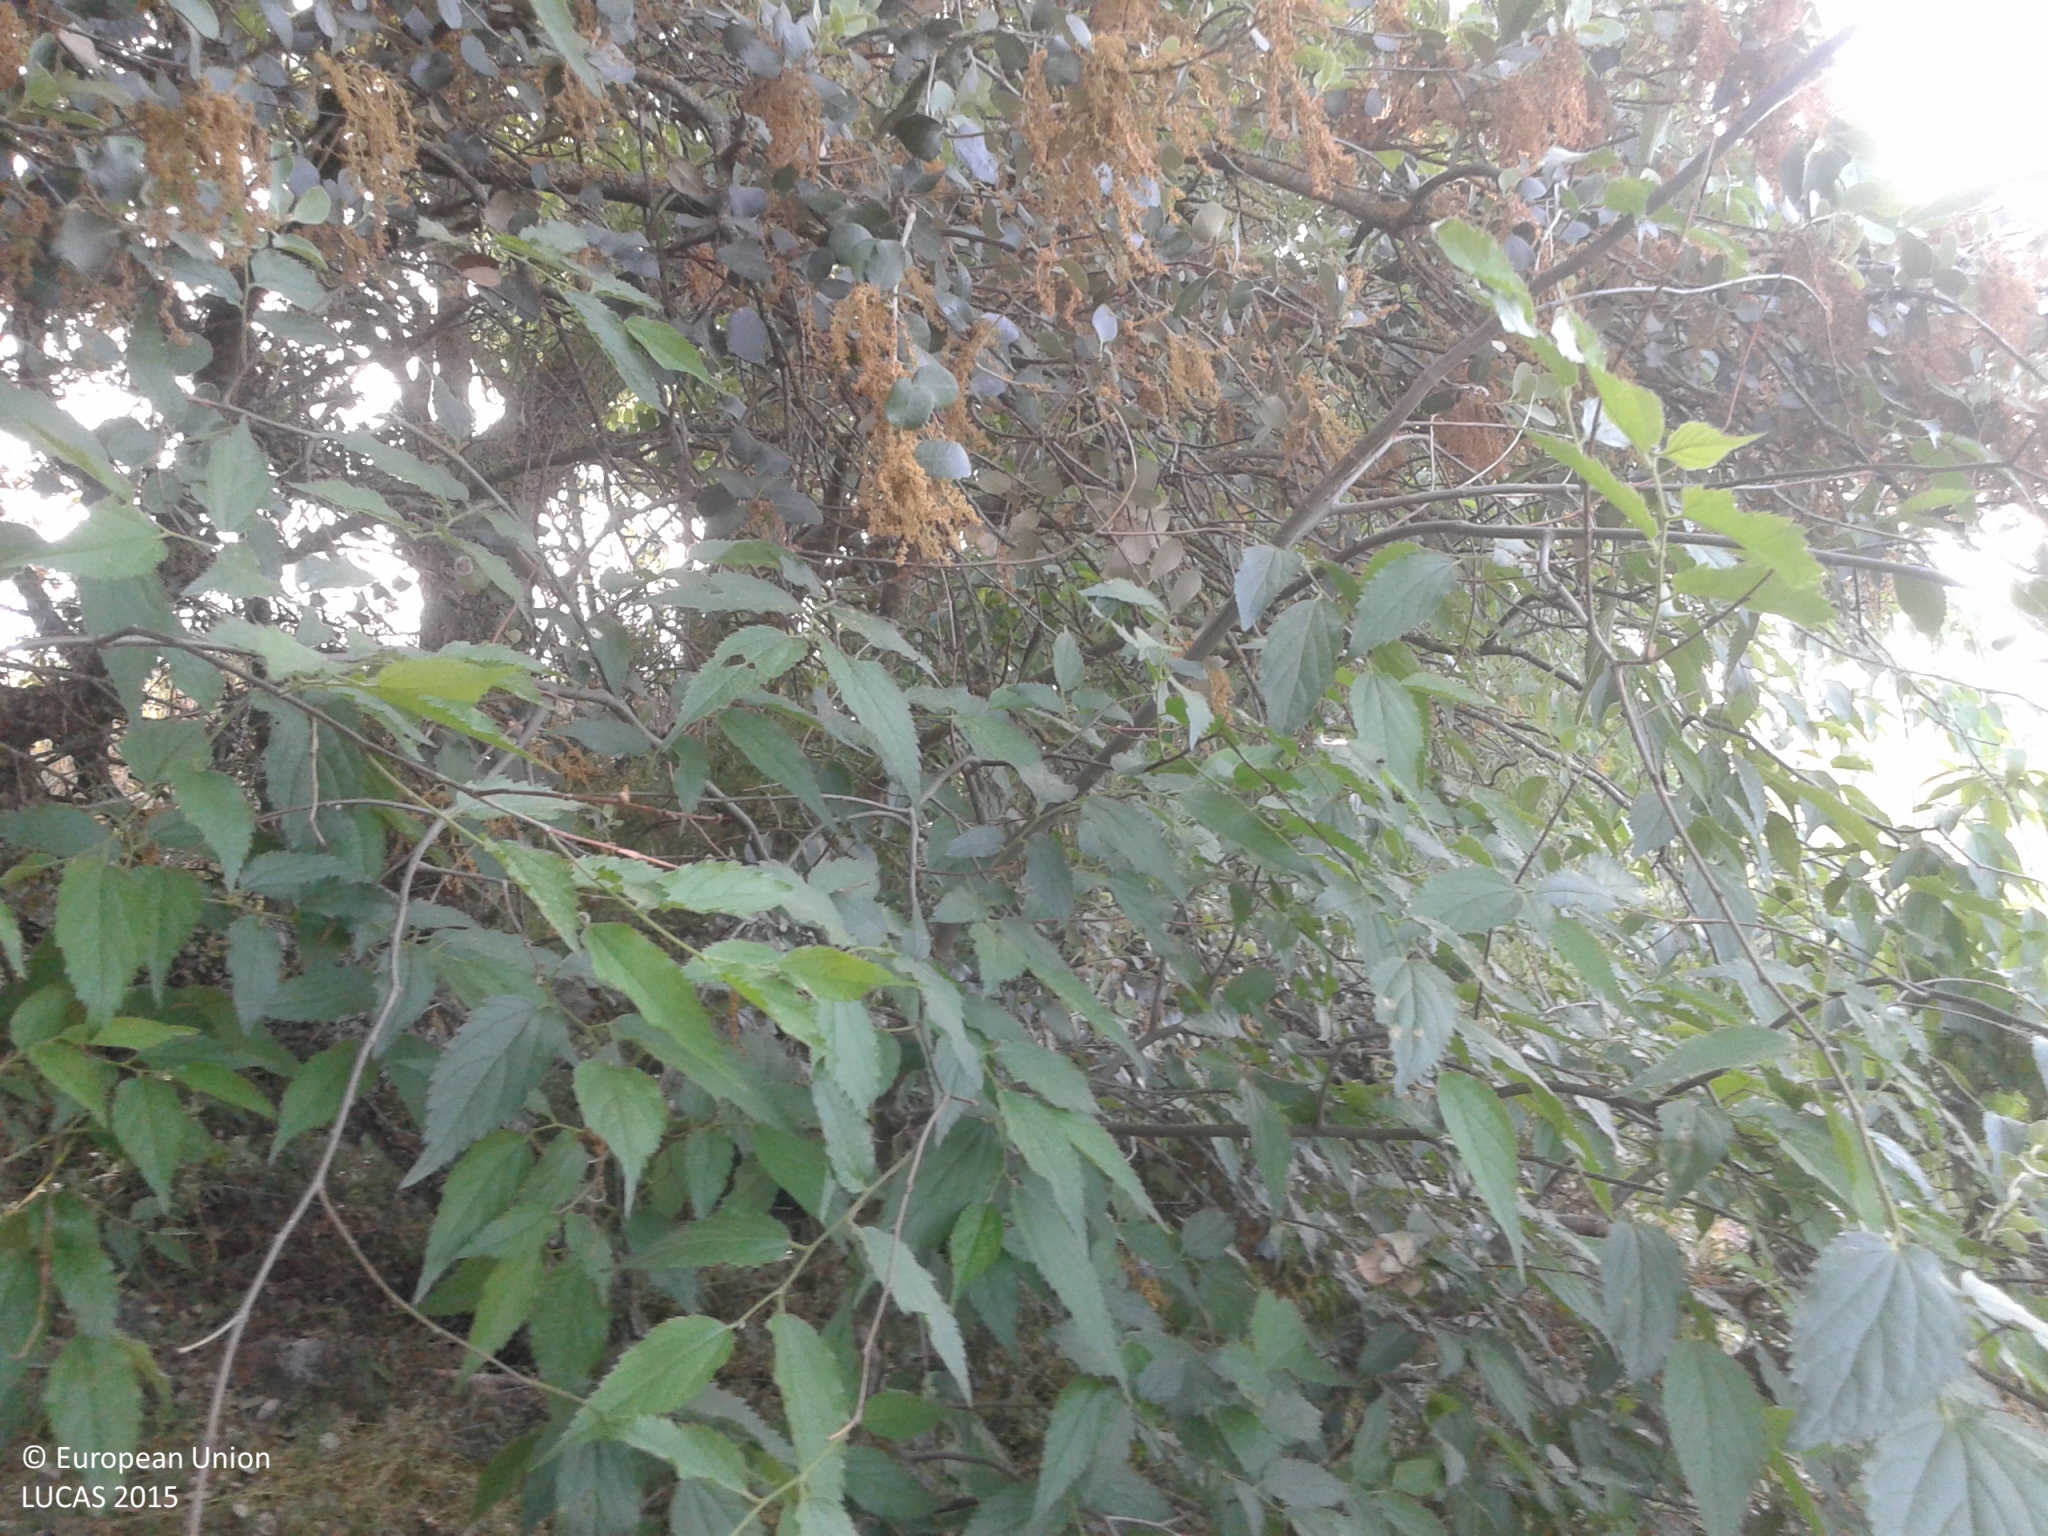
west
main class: Woodland
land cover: Broadleaved woodland
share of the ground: > 75 %
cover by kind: broadleaved forest trees 90 %, shrubs 5 %, herbaceous plants 5 %
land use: Semi-natural and natural areas not in use
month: May
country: ES
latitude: 41.8371
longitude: 0.6292
